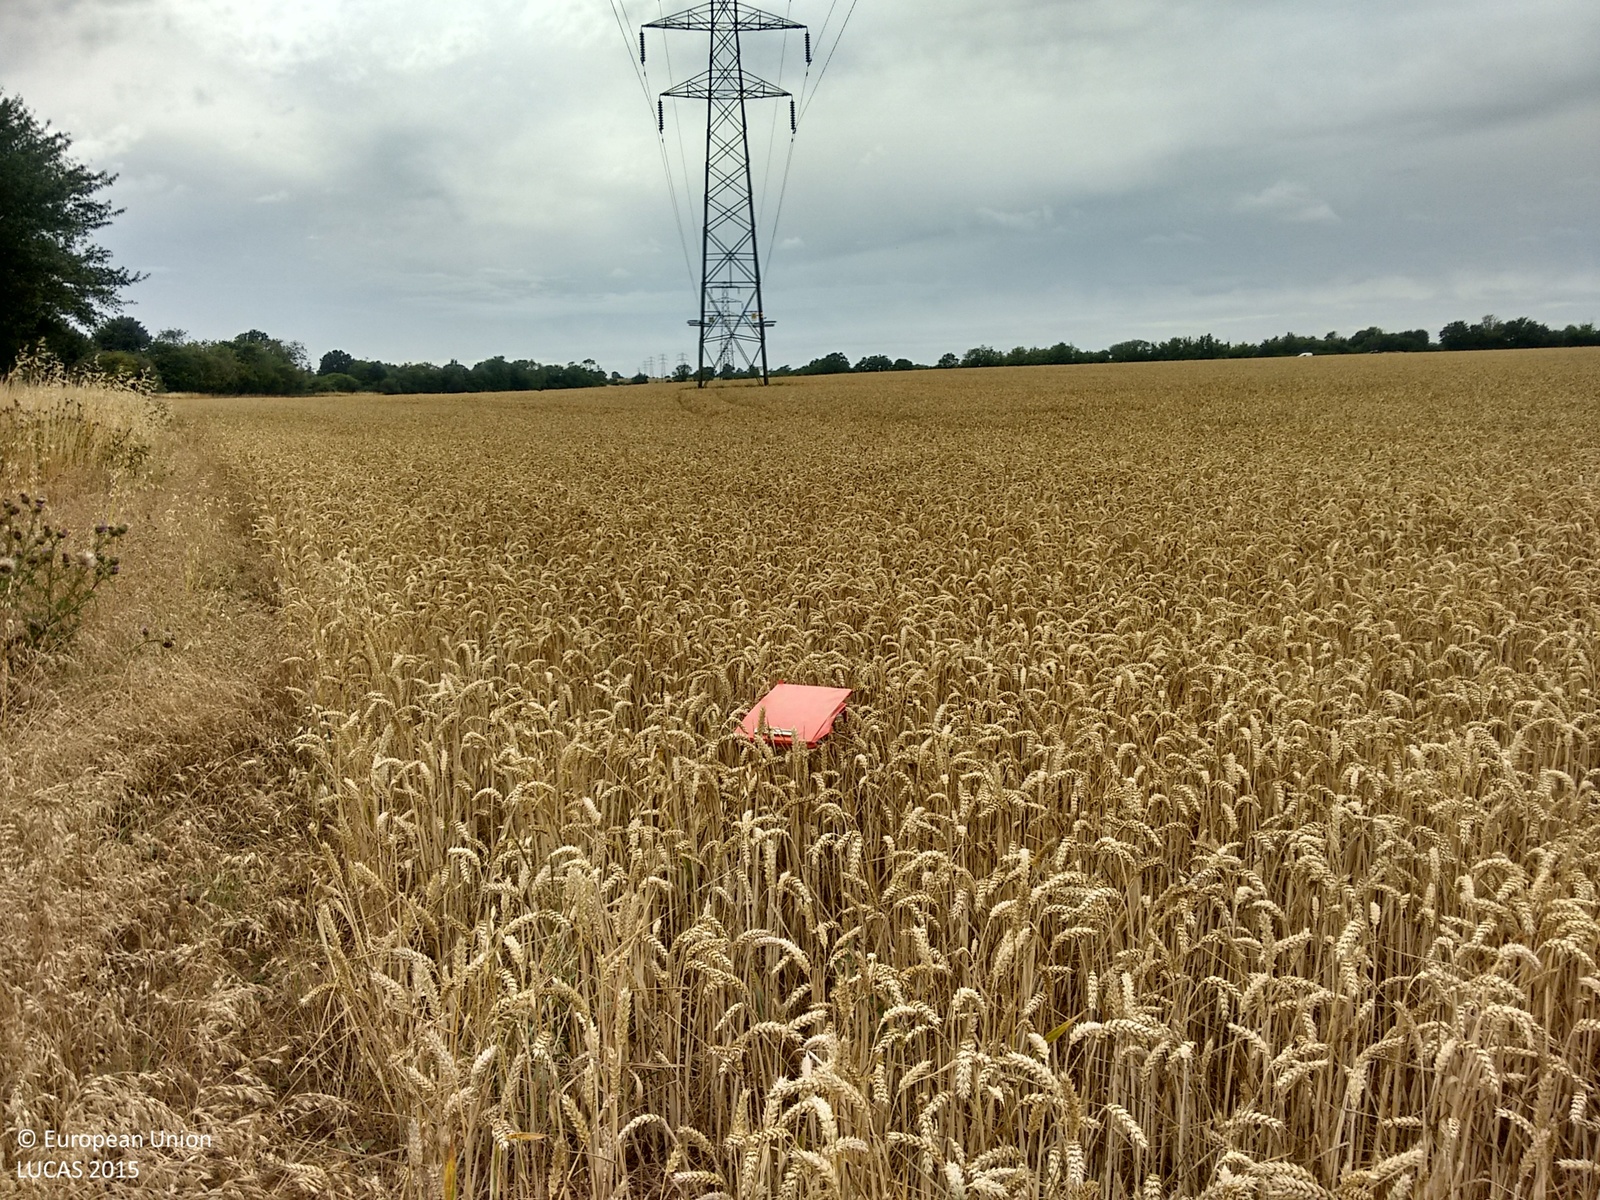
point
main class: Cropland
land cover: Common wheat
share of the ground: > 75 %
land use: Agriculture (excluding fallow land and kitchen gardens)
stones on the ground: 10 - 25 %
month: August
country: GB
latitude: 51.9950
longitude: 0.4909
